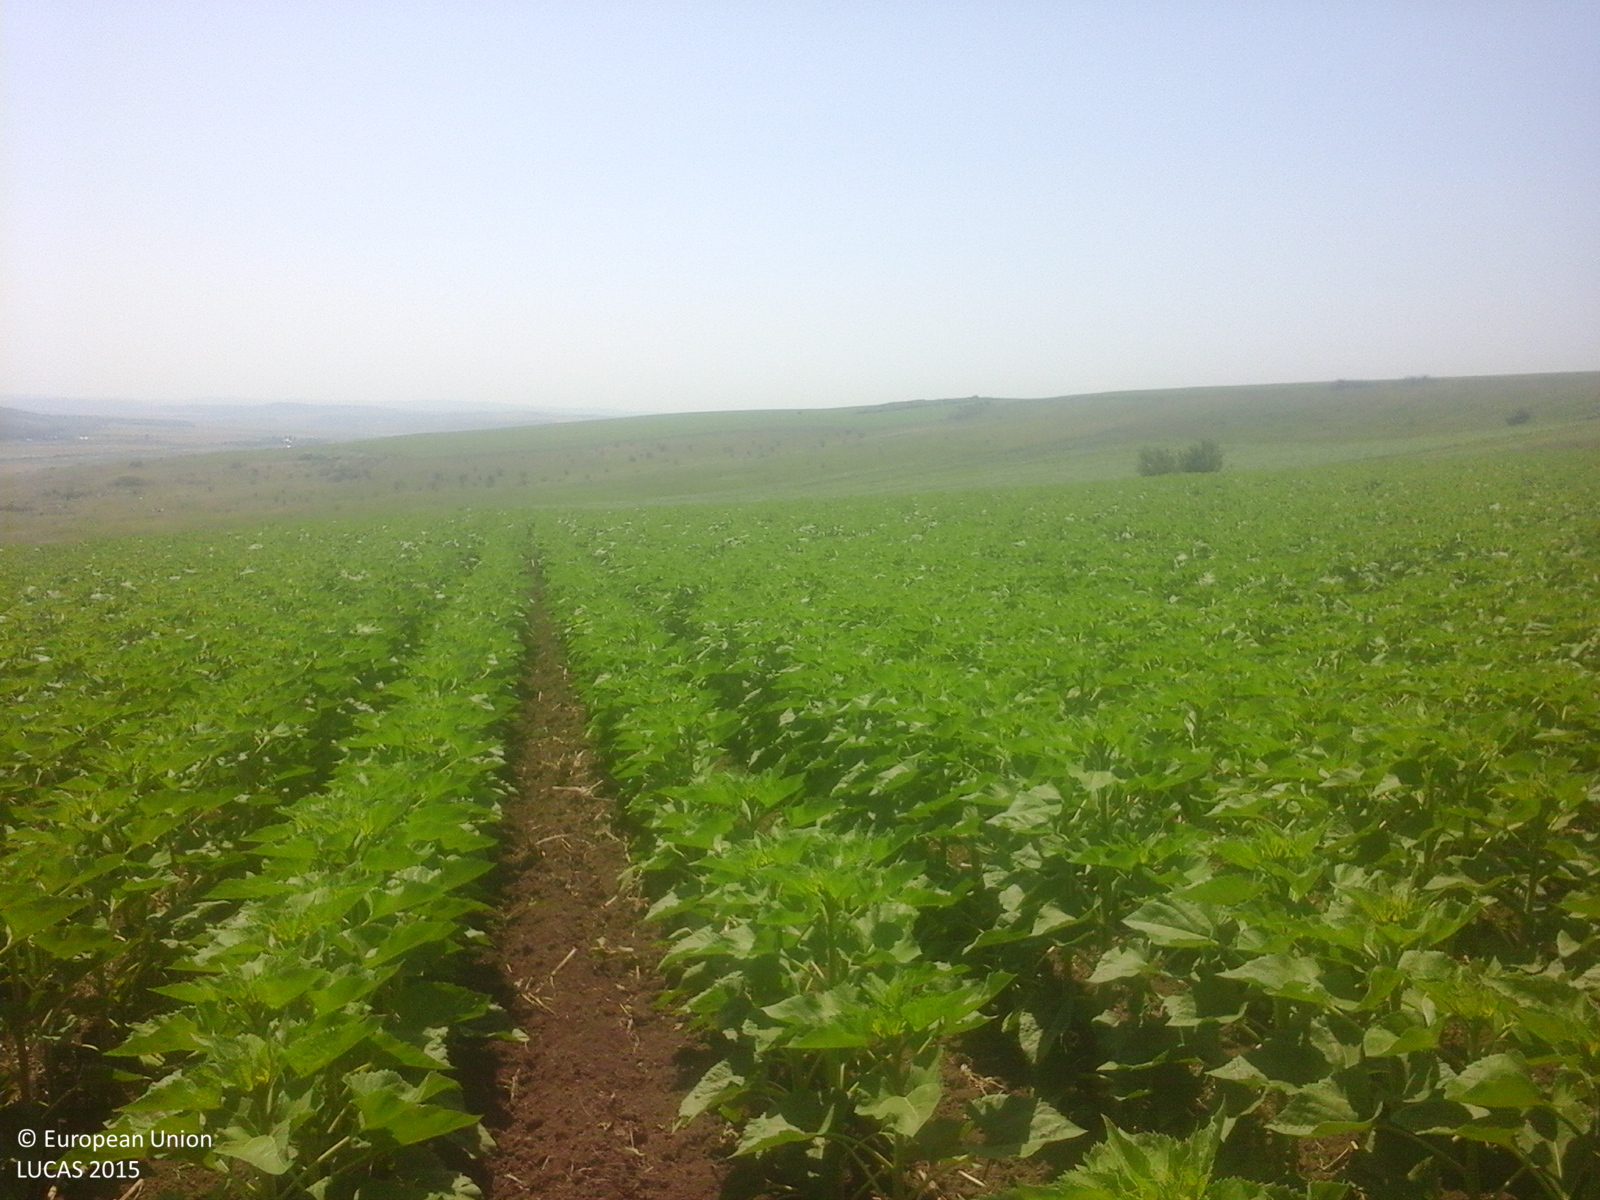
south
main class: Cropland
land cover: Sunflower
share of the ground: > 75 %
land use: Agriculture (excluding fallow land and kitchen gardens)
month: June
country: RO
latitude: 46.8391
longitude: 27.5403
